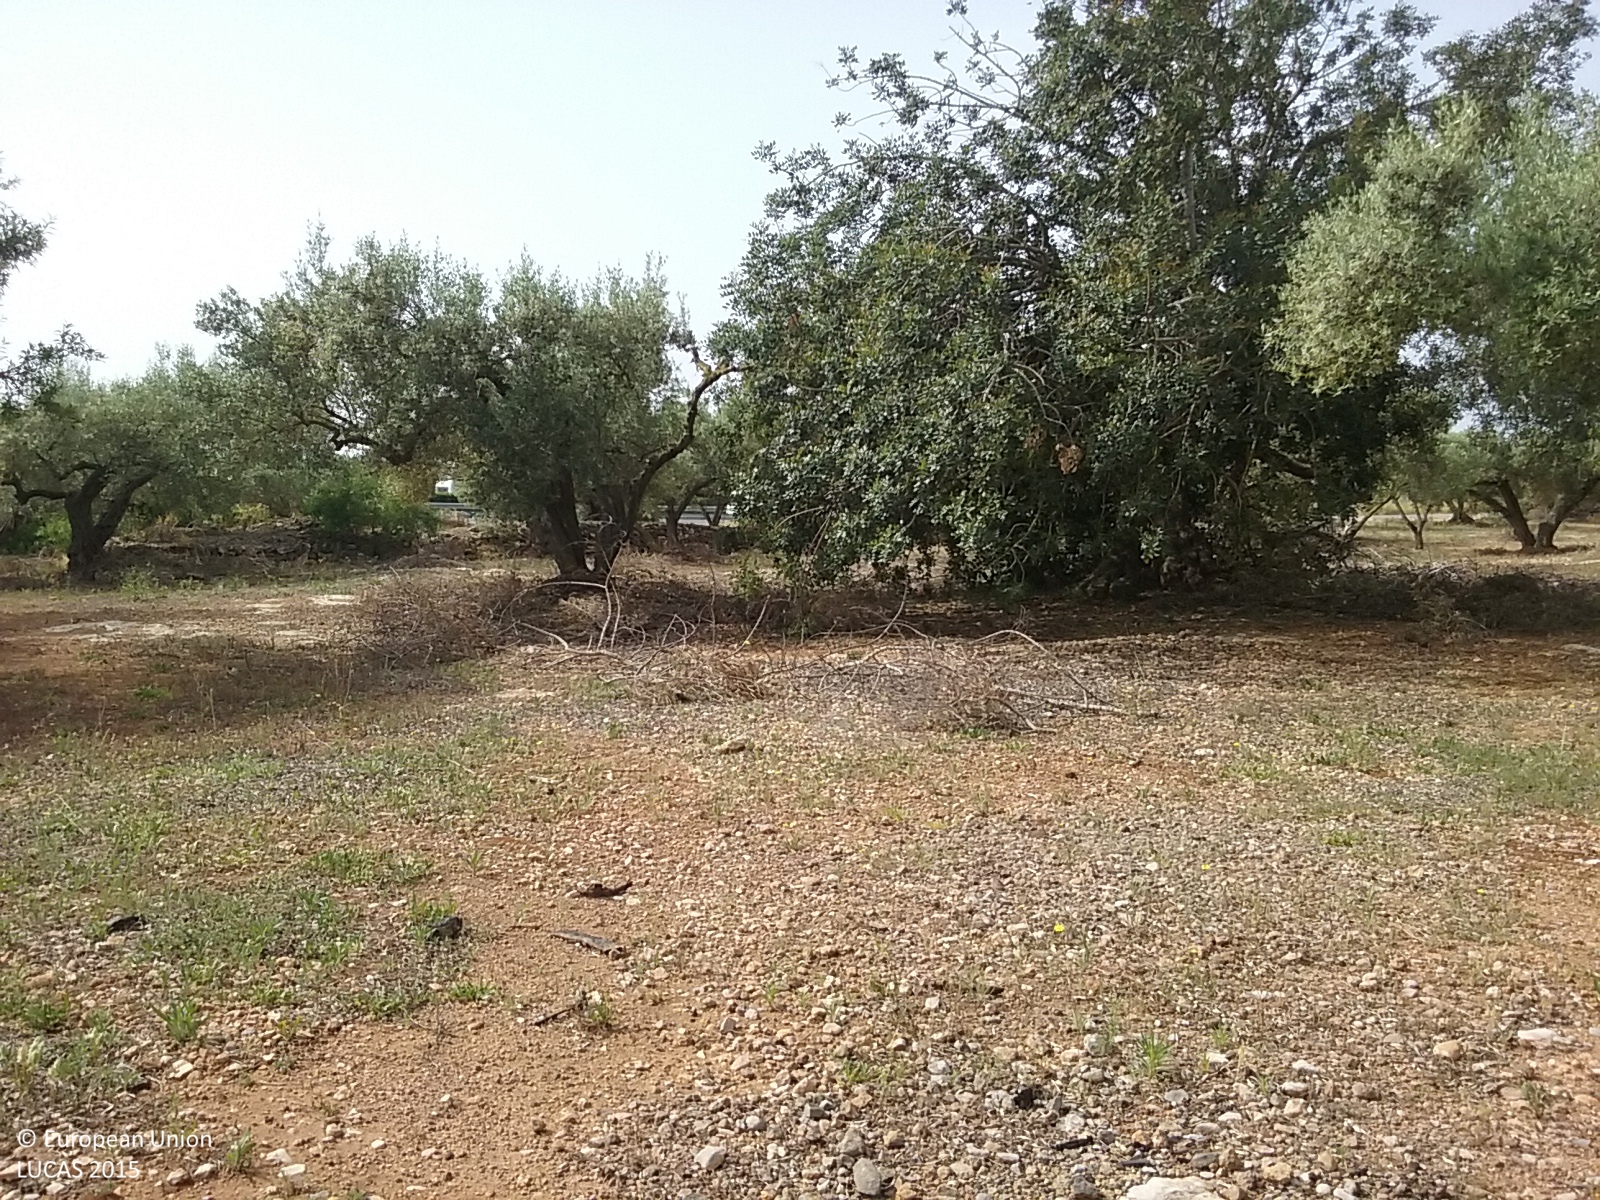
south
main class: Cropland
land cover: Olive groves
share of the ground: 25 - 50 %
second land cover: Spontaneously vegetated surfaces
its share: 25 - 50 %
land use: Agriculture (excluding fallow land and kitchen gardens)
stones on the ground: 25 - 50 %
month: May
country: ES
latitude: 40.7638
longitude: 0.6242
